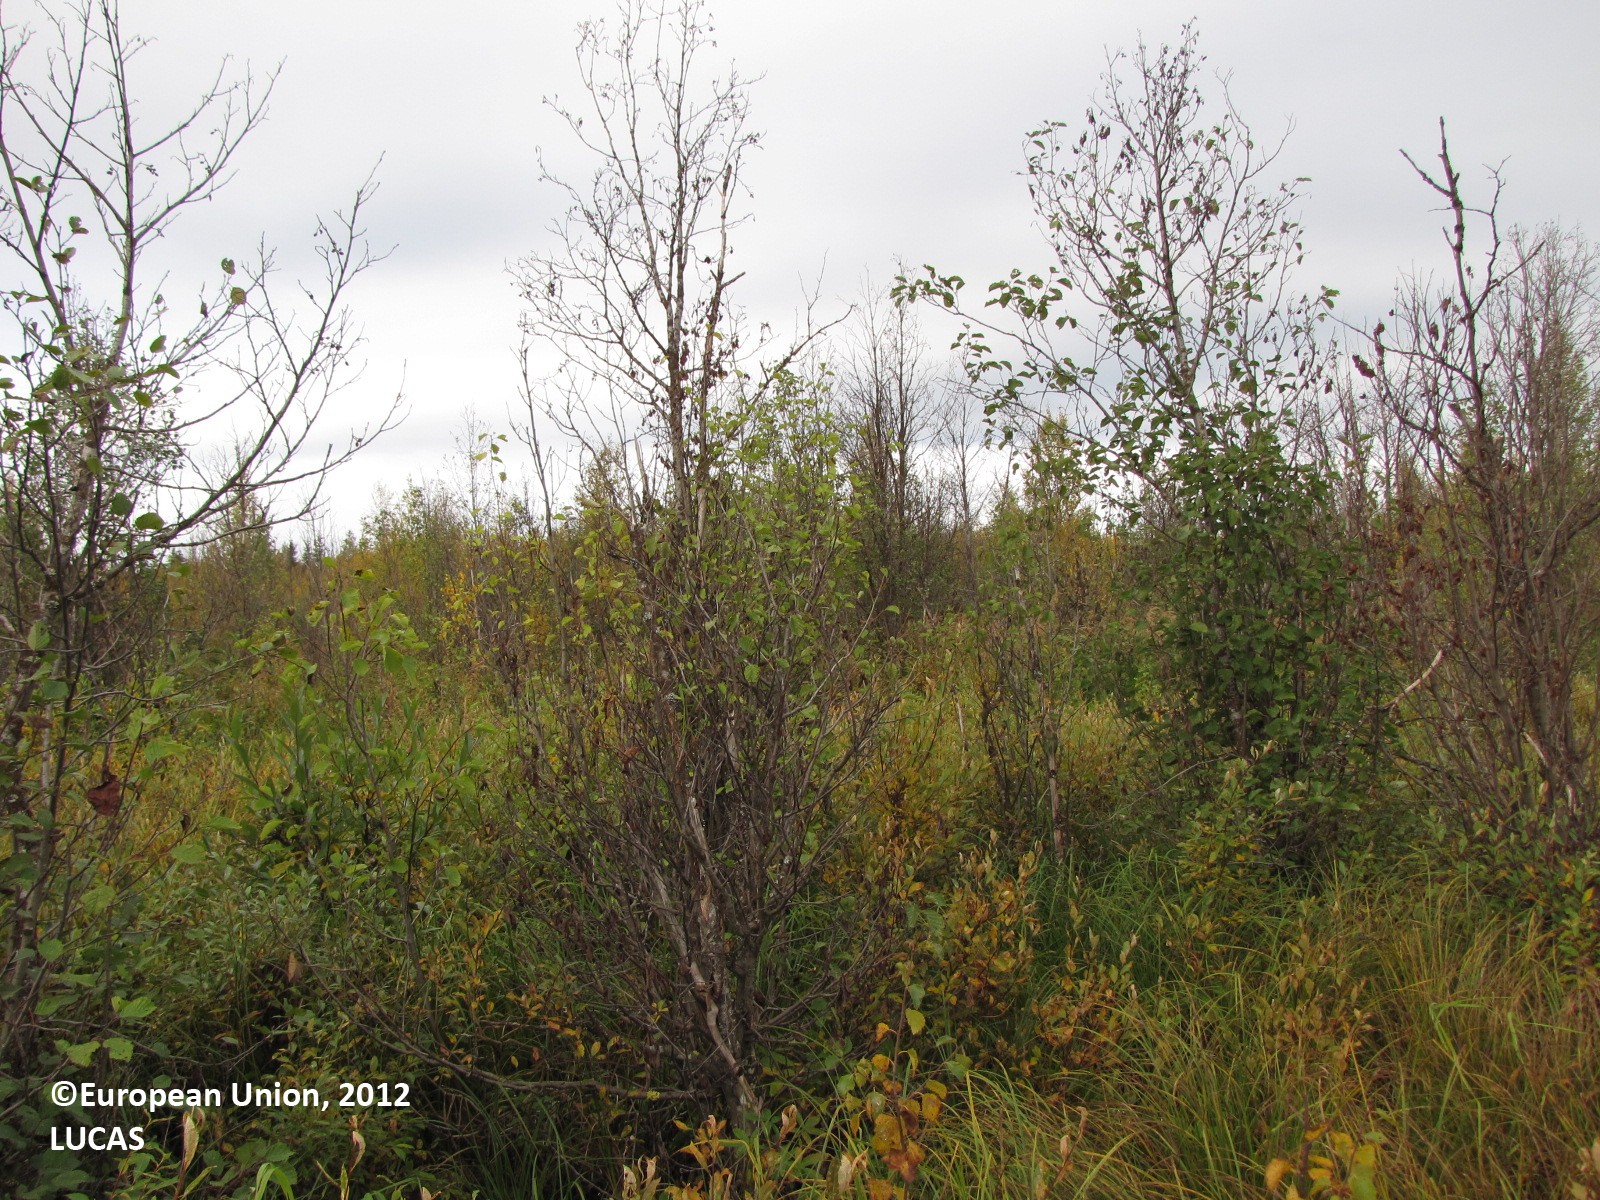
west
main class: Woodland
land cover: Broadleaved woodland
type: boreal forest
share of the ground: 10 - 25 %
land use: Forestry
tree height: > 5 m
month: September
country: FI
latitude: 67.1983
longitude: 23.5945
